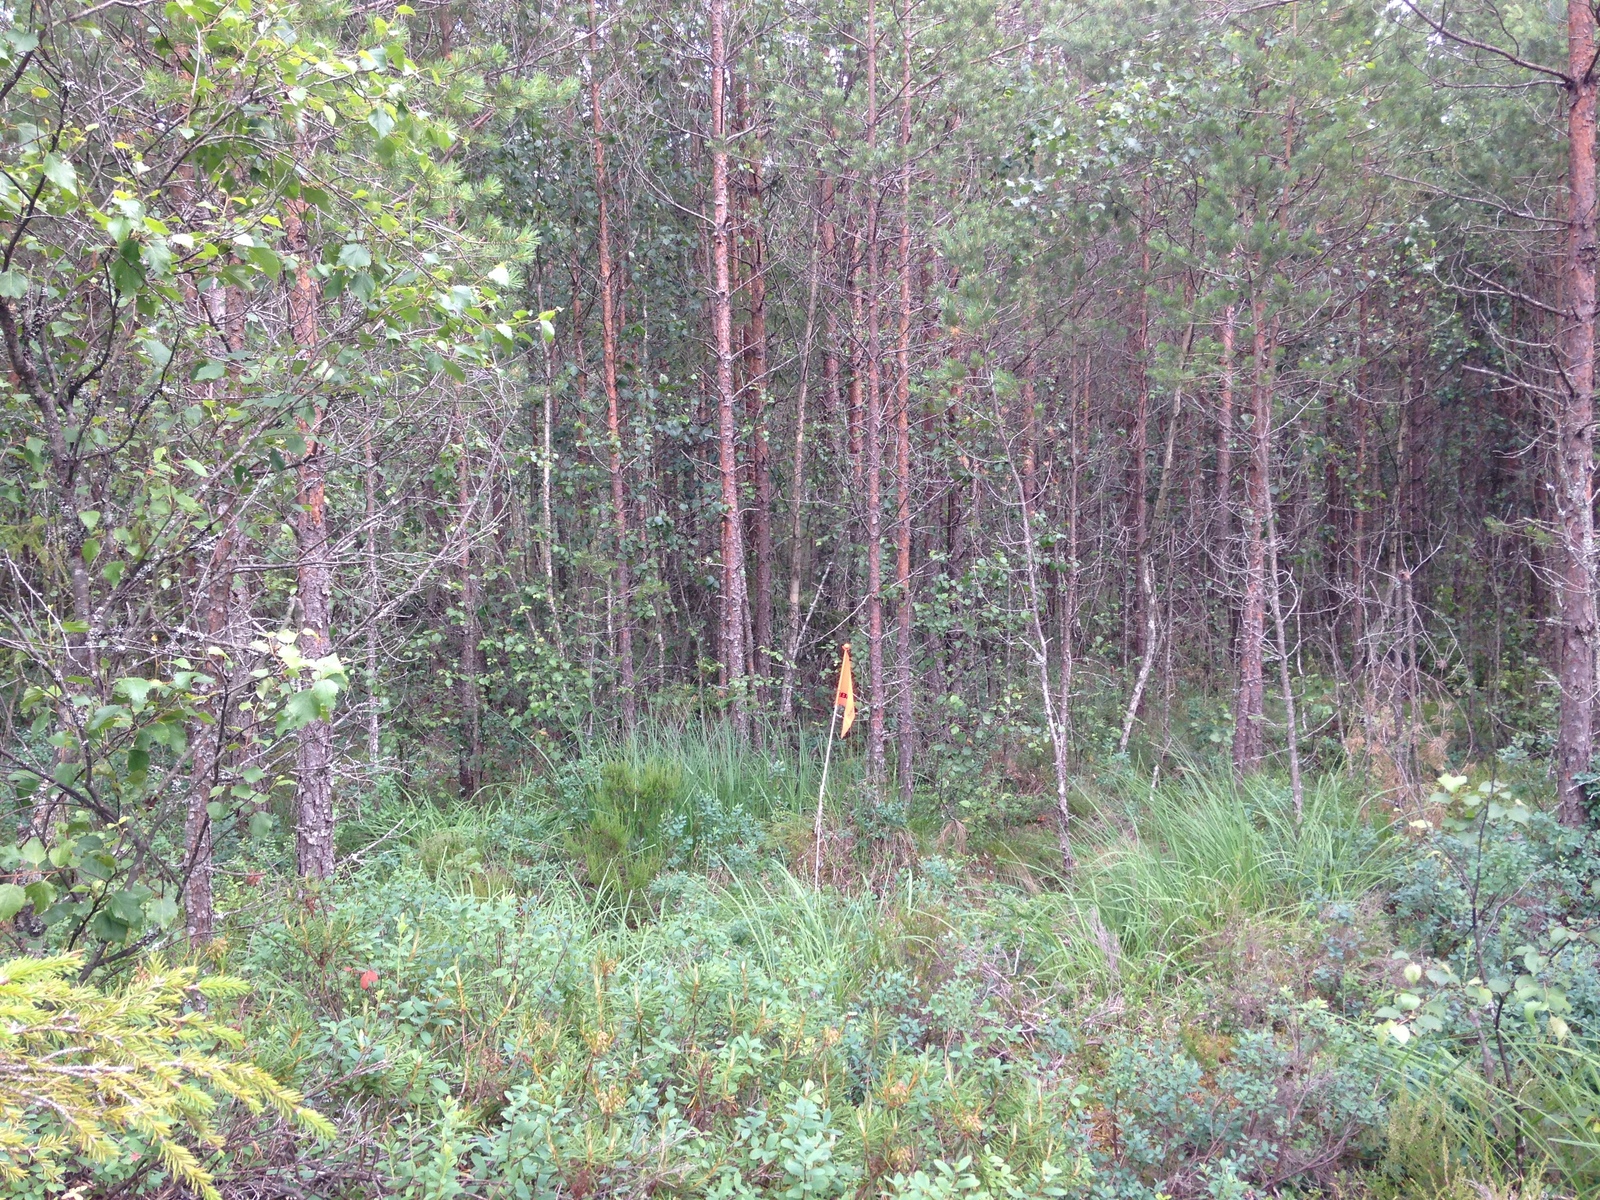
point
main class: Woodland
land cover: Pine dominated coniferous woodland
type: boreal forest
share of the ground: 50 - 75 %
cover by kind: coniferous forest trees 55 %, shrubs 25 %, herbaceous plants 10 %, broadleaved forest trees 5 %, lichens and mosses 5 %
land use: Semi-natural and natural areas not in use
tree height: < 5 m
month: July
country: SE
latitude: 58.9889
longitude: 14.5690
